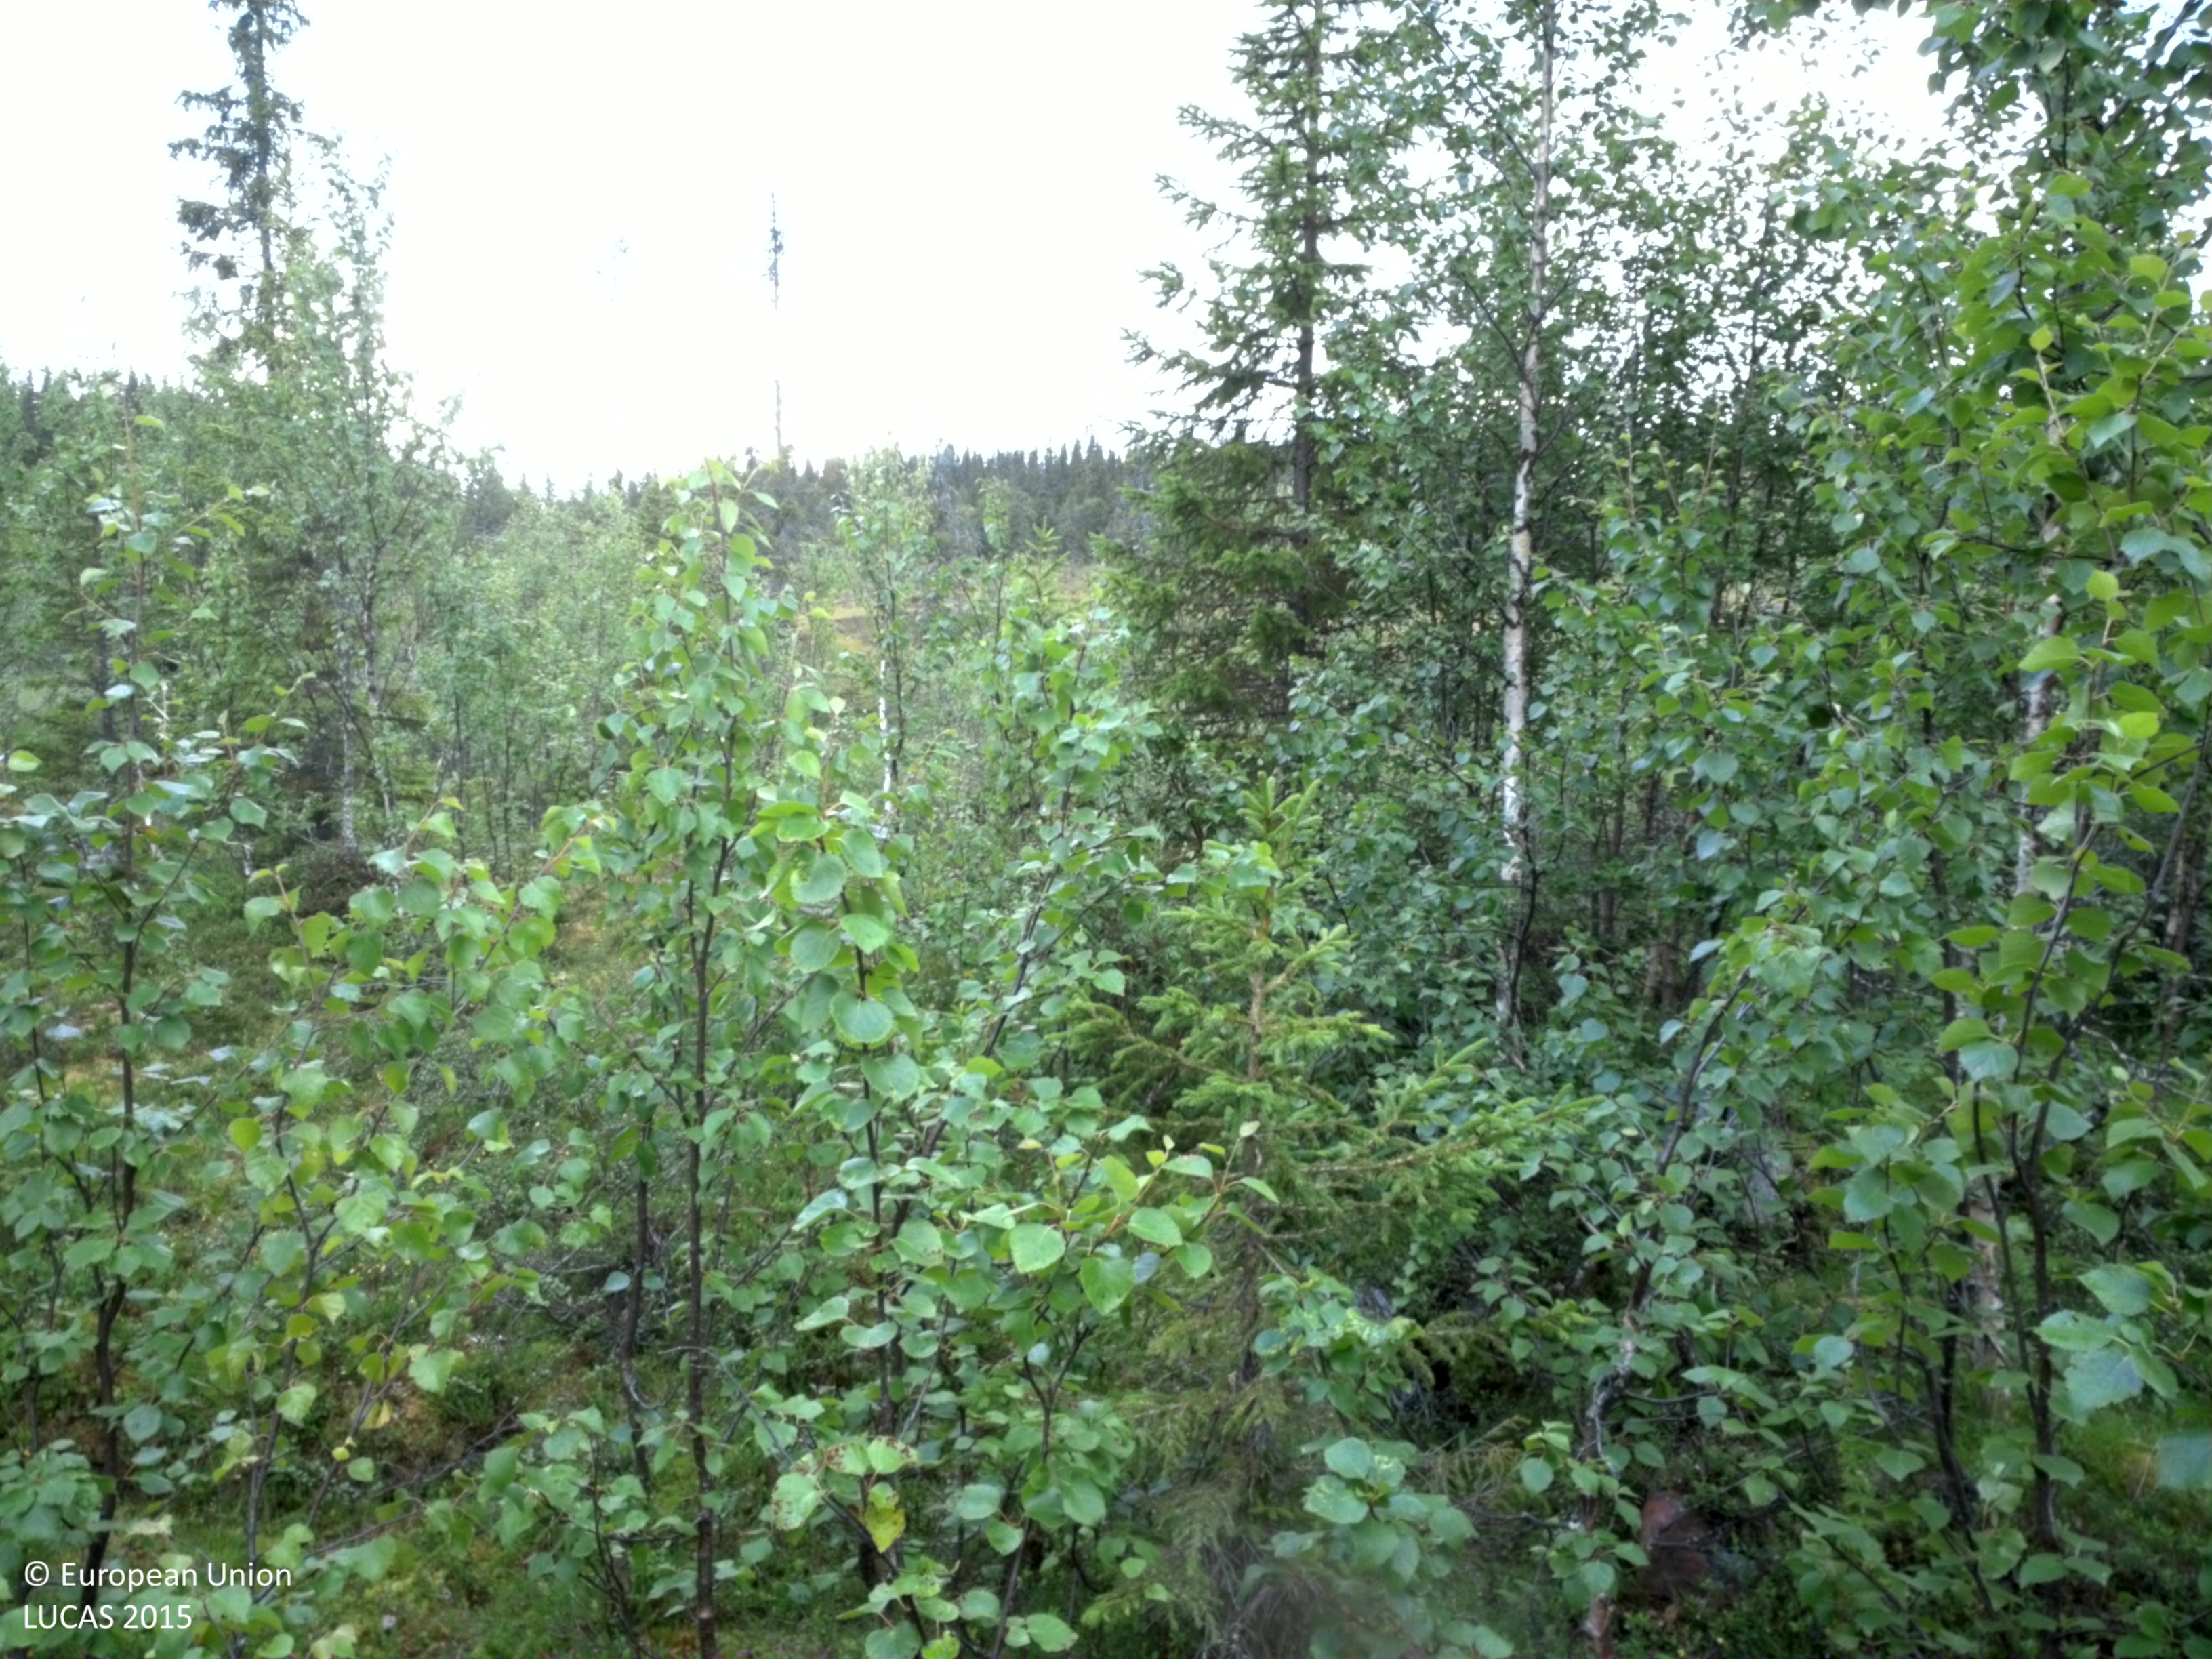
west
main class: Woodland
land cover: Spruce dominated mixed woodland
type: boreal forest
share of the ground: 25 - 50 %
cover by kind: shrubs 40 %, broadleaved forest trees 25 %, coniferous forest trees 15 %, lichens and mosses 15 %, herbaceous plants 5 %
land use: Forestry
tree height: > 5 m
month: August
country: SE
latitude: 64.8377
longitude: 16.2267
